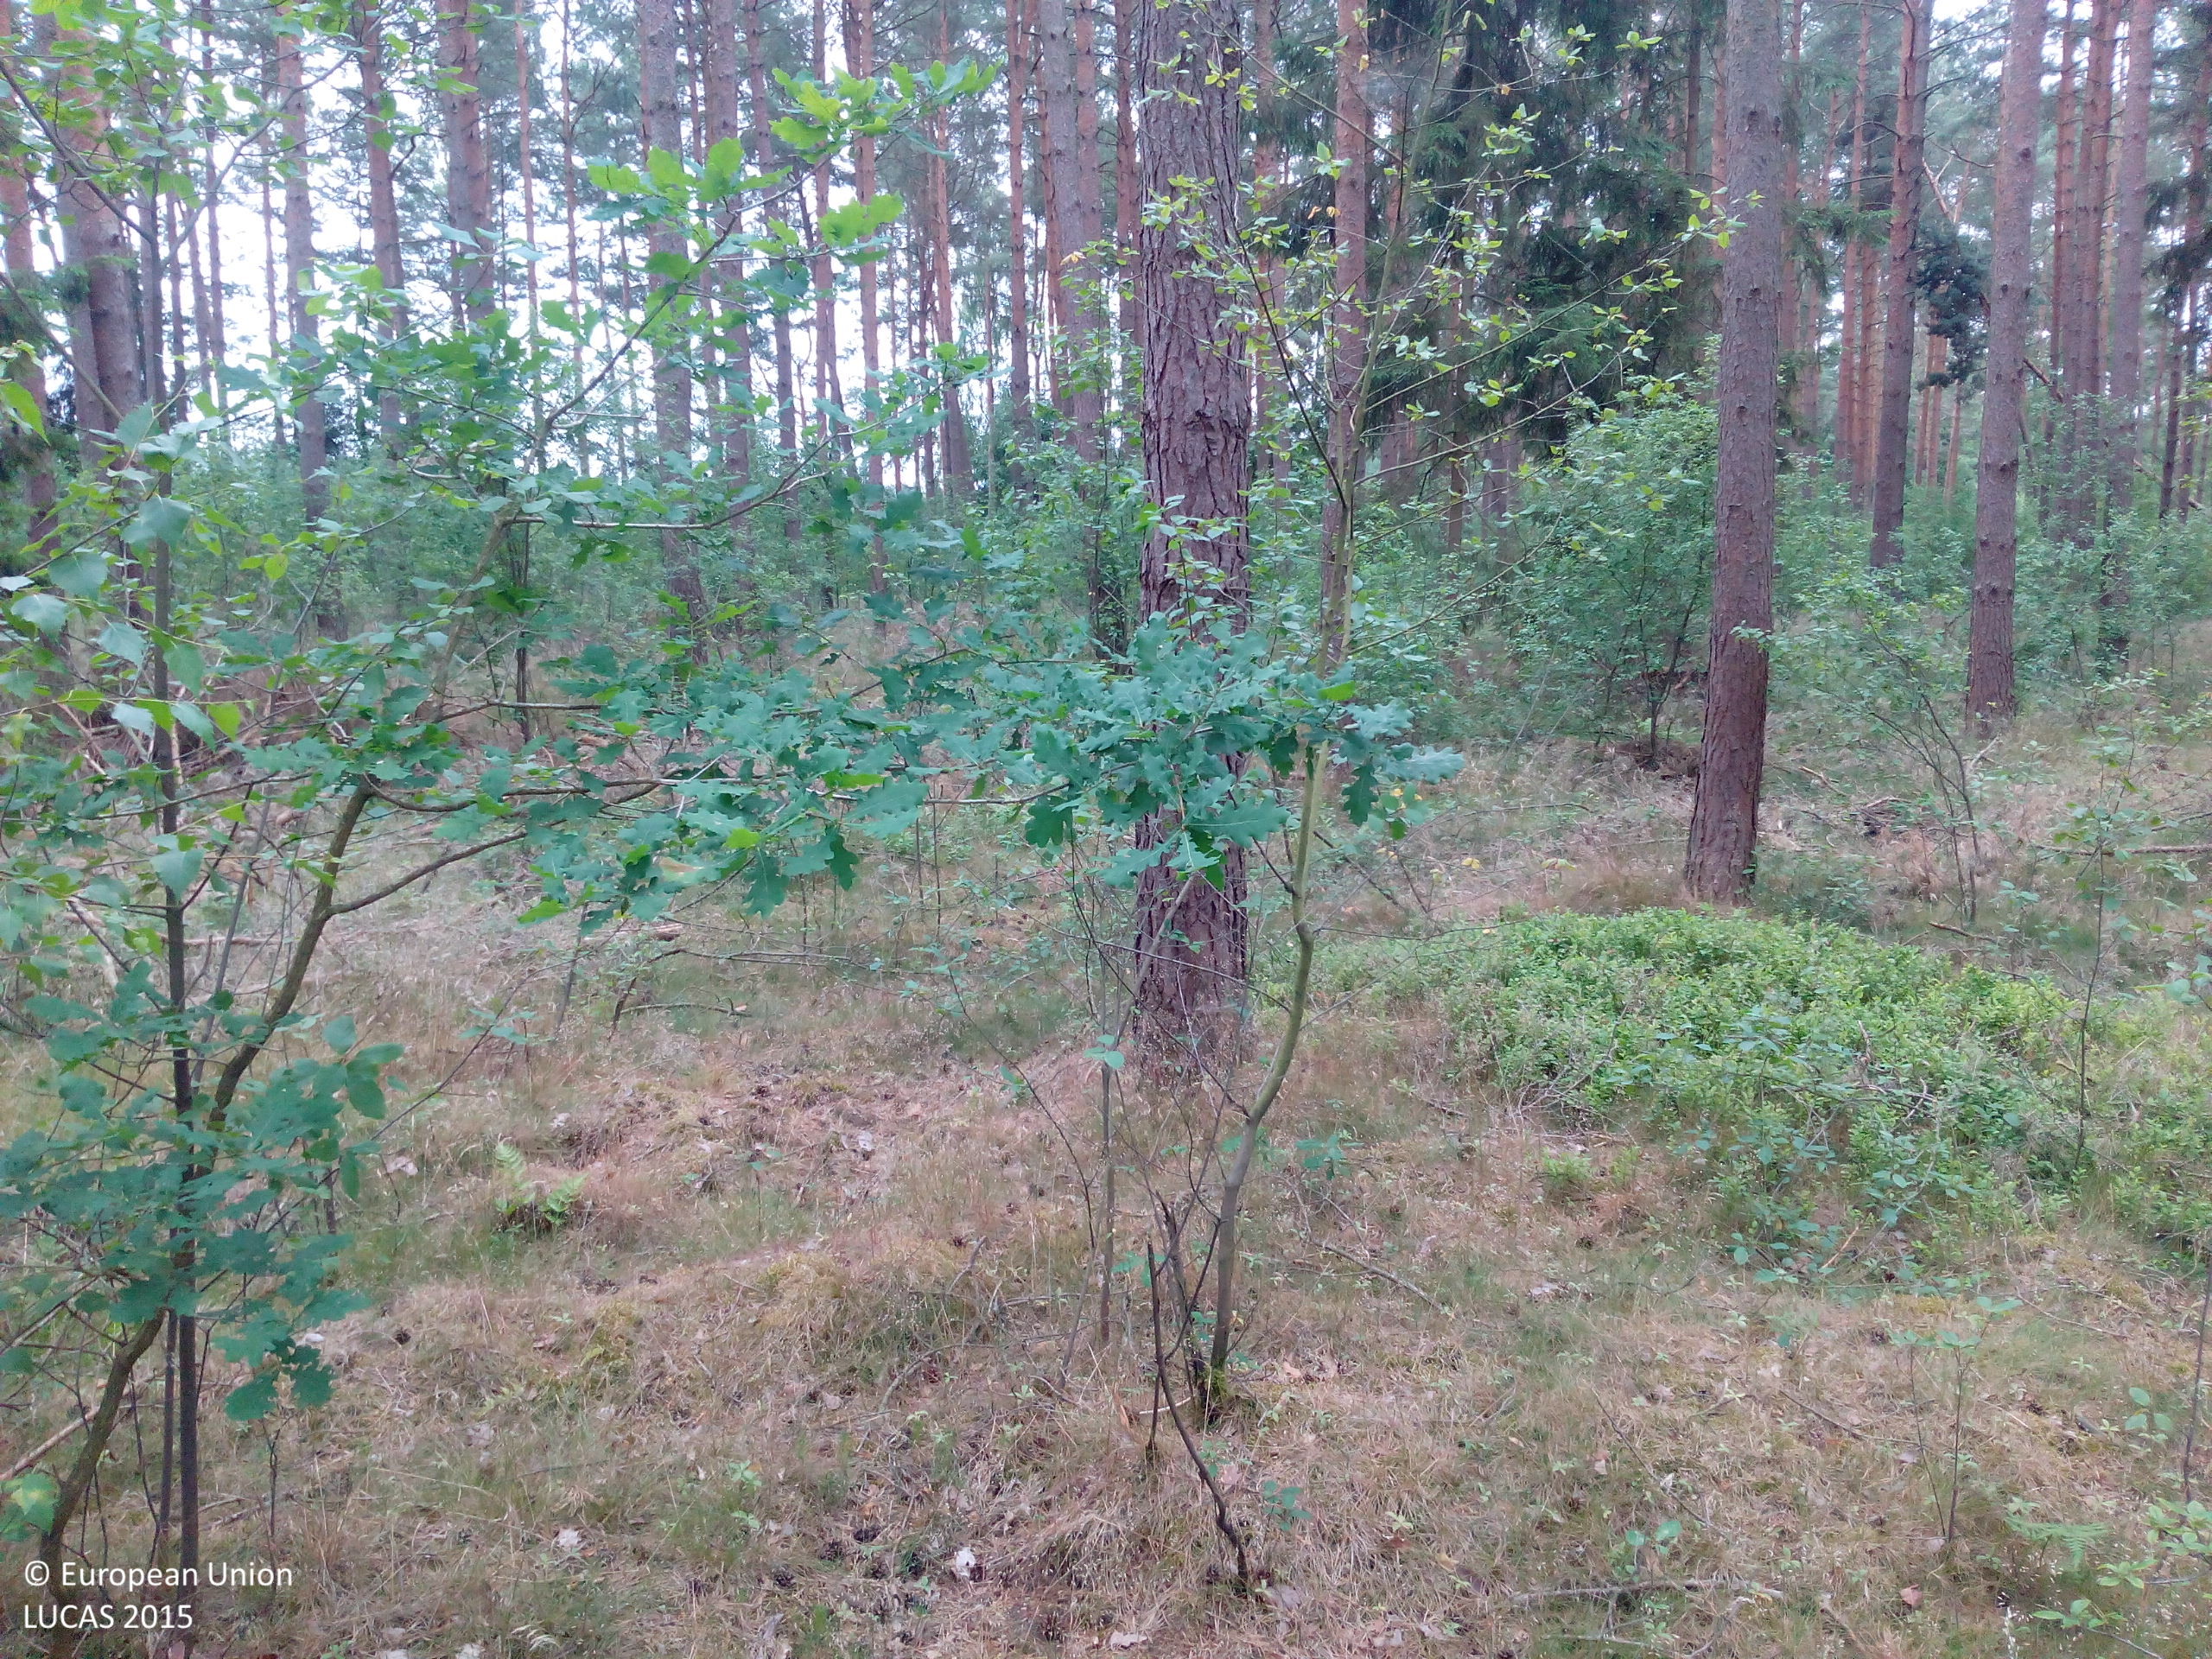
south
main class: Woodland
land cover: Pine dominated coniferous woodland
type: hemiboreal forest and nemoral coniferous forest and mixed broadleaved-coniferous forest
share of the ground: 50 - 75 %
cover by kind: coniferous forest trees 70 %, broadleaved forest trees 15 %, herbaceous plants 15 %
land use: Forestry
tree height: > 5 m
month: July
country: DE
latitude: 52.7007
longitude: 10.2811
